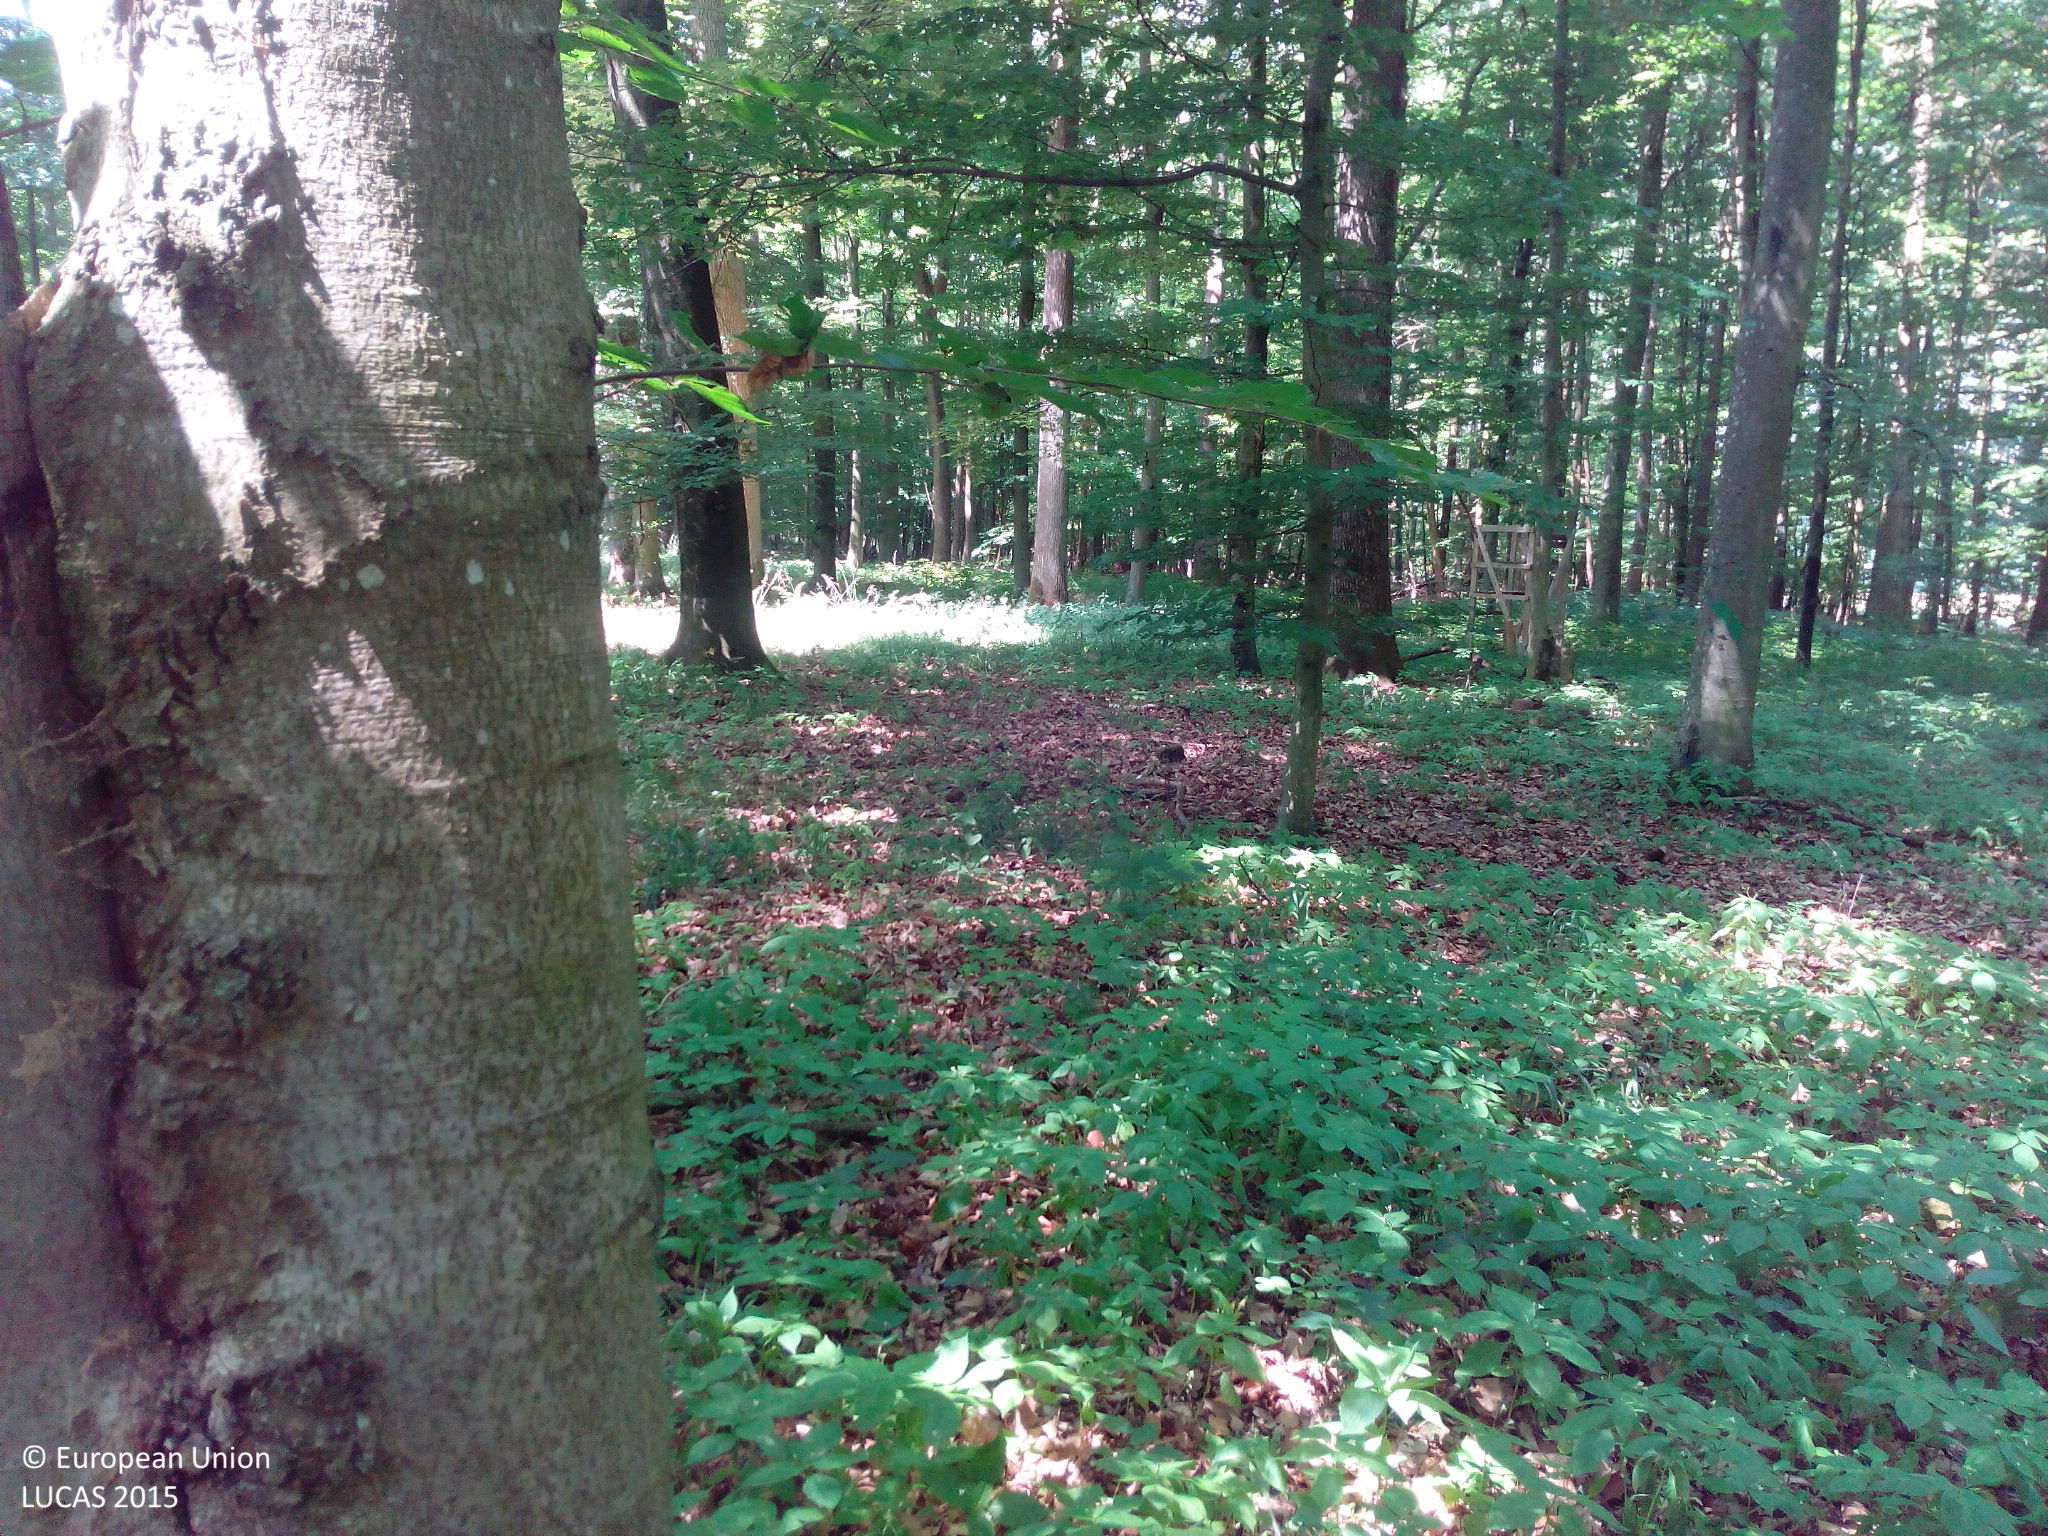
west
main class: Woodland
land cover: Broadleaved woodland
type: mesophytic deciduous forest
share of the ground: > 75 %
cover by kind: broadleaved forest trees 90 %, herbaceous plants 10 %
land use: Forestry
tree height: > 5 m
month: July
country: DE
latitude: 49.5368
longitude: 9.9309
